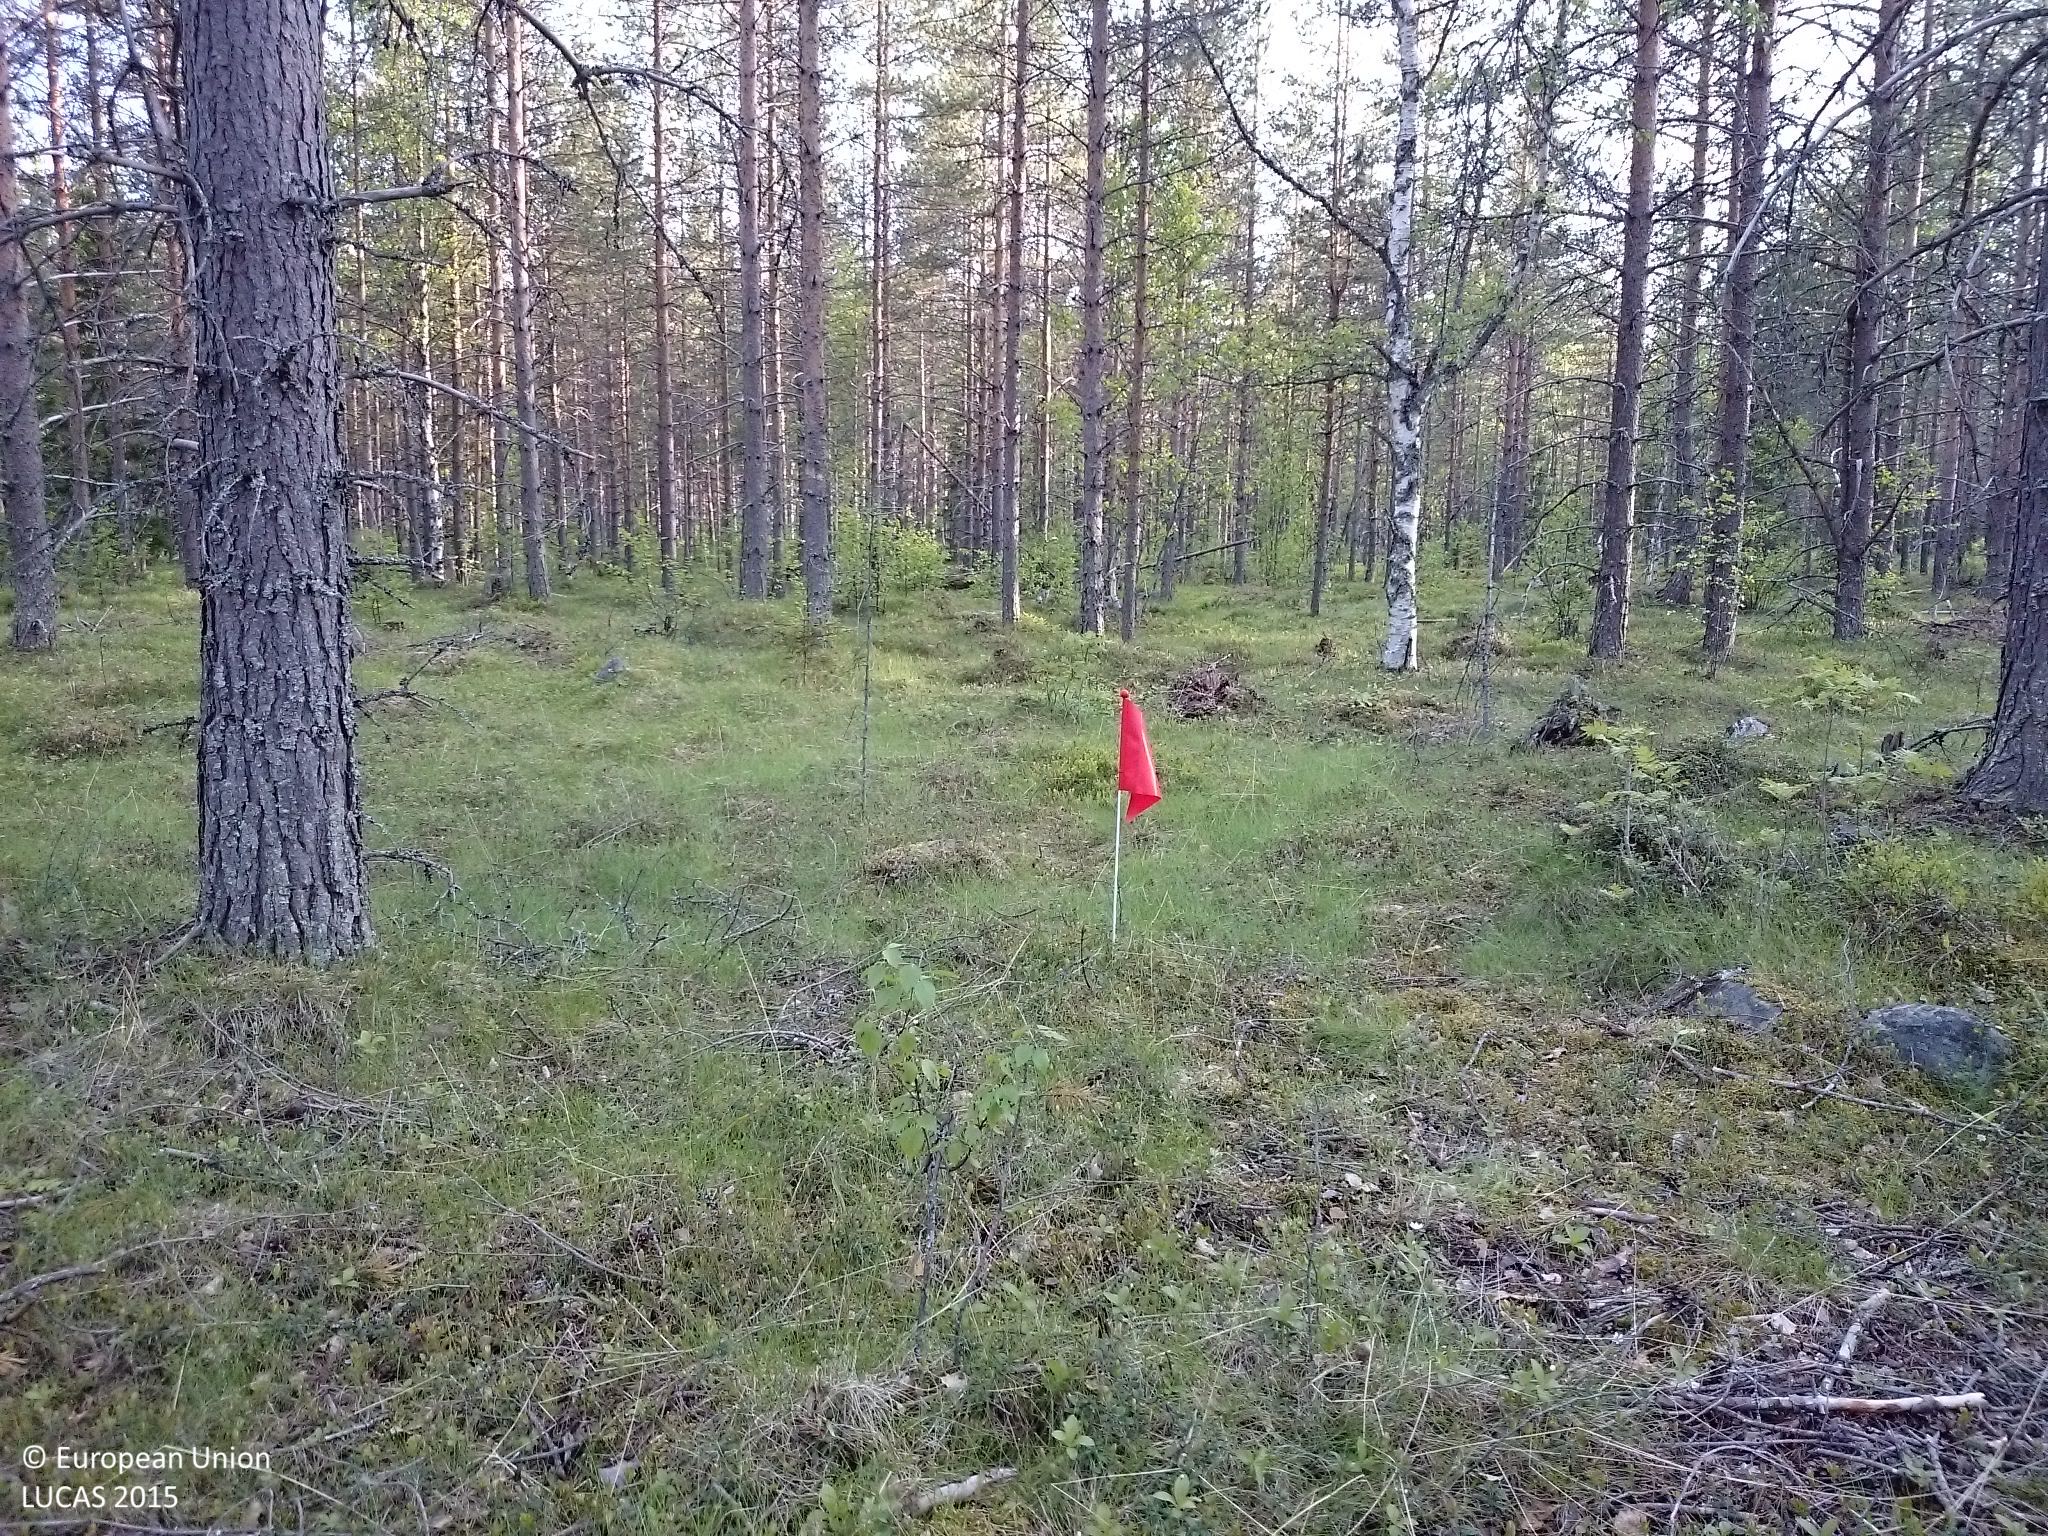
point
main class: Woodland
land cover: Pine dominated mixed woodland
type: boreal forest
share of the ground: 50 - 75 %
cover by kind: coniferous forest trees 45 %, shrubs 25 %, broadleaved forest trees 15 %, herbaceous plants 15 %
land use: Forestry
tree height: > 5 m
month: June
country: SE
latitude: 64.0446
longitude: 20.5693
